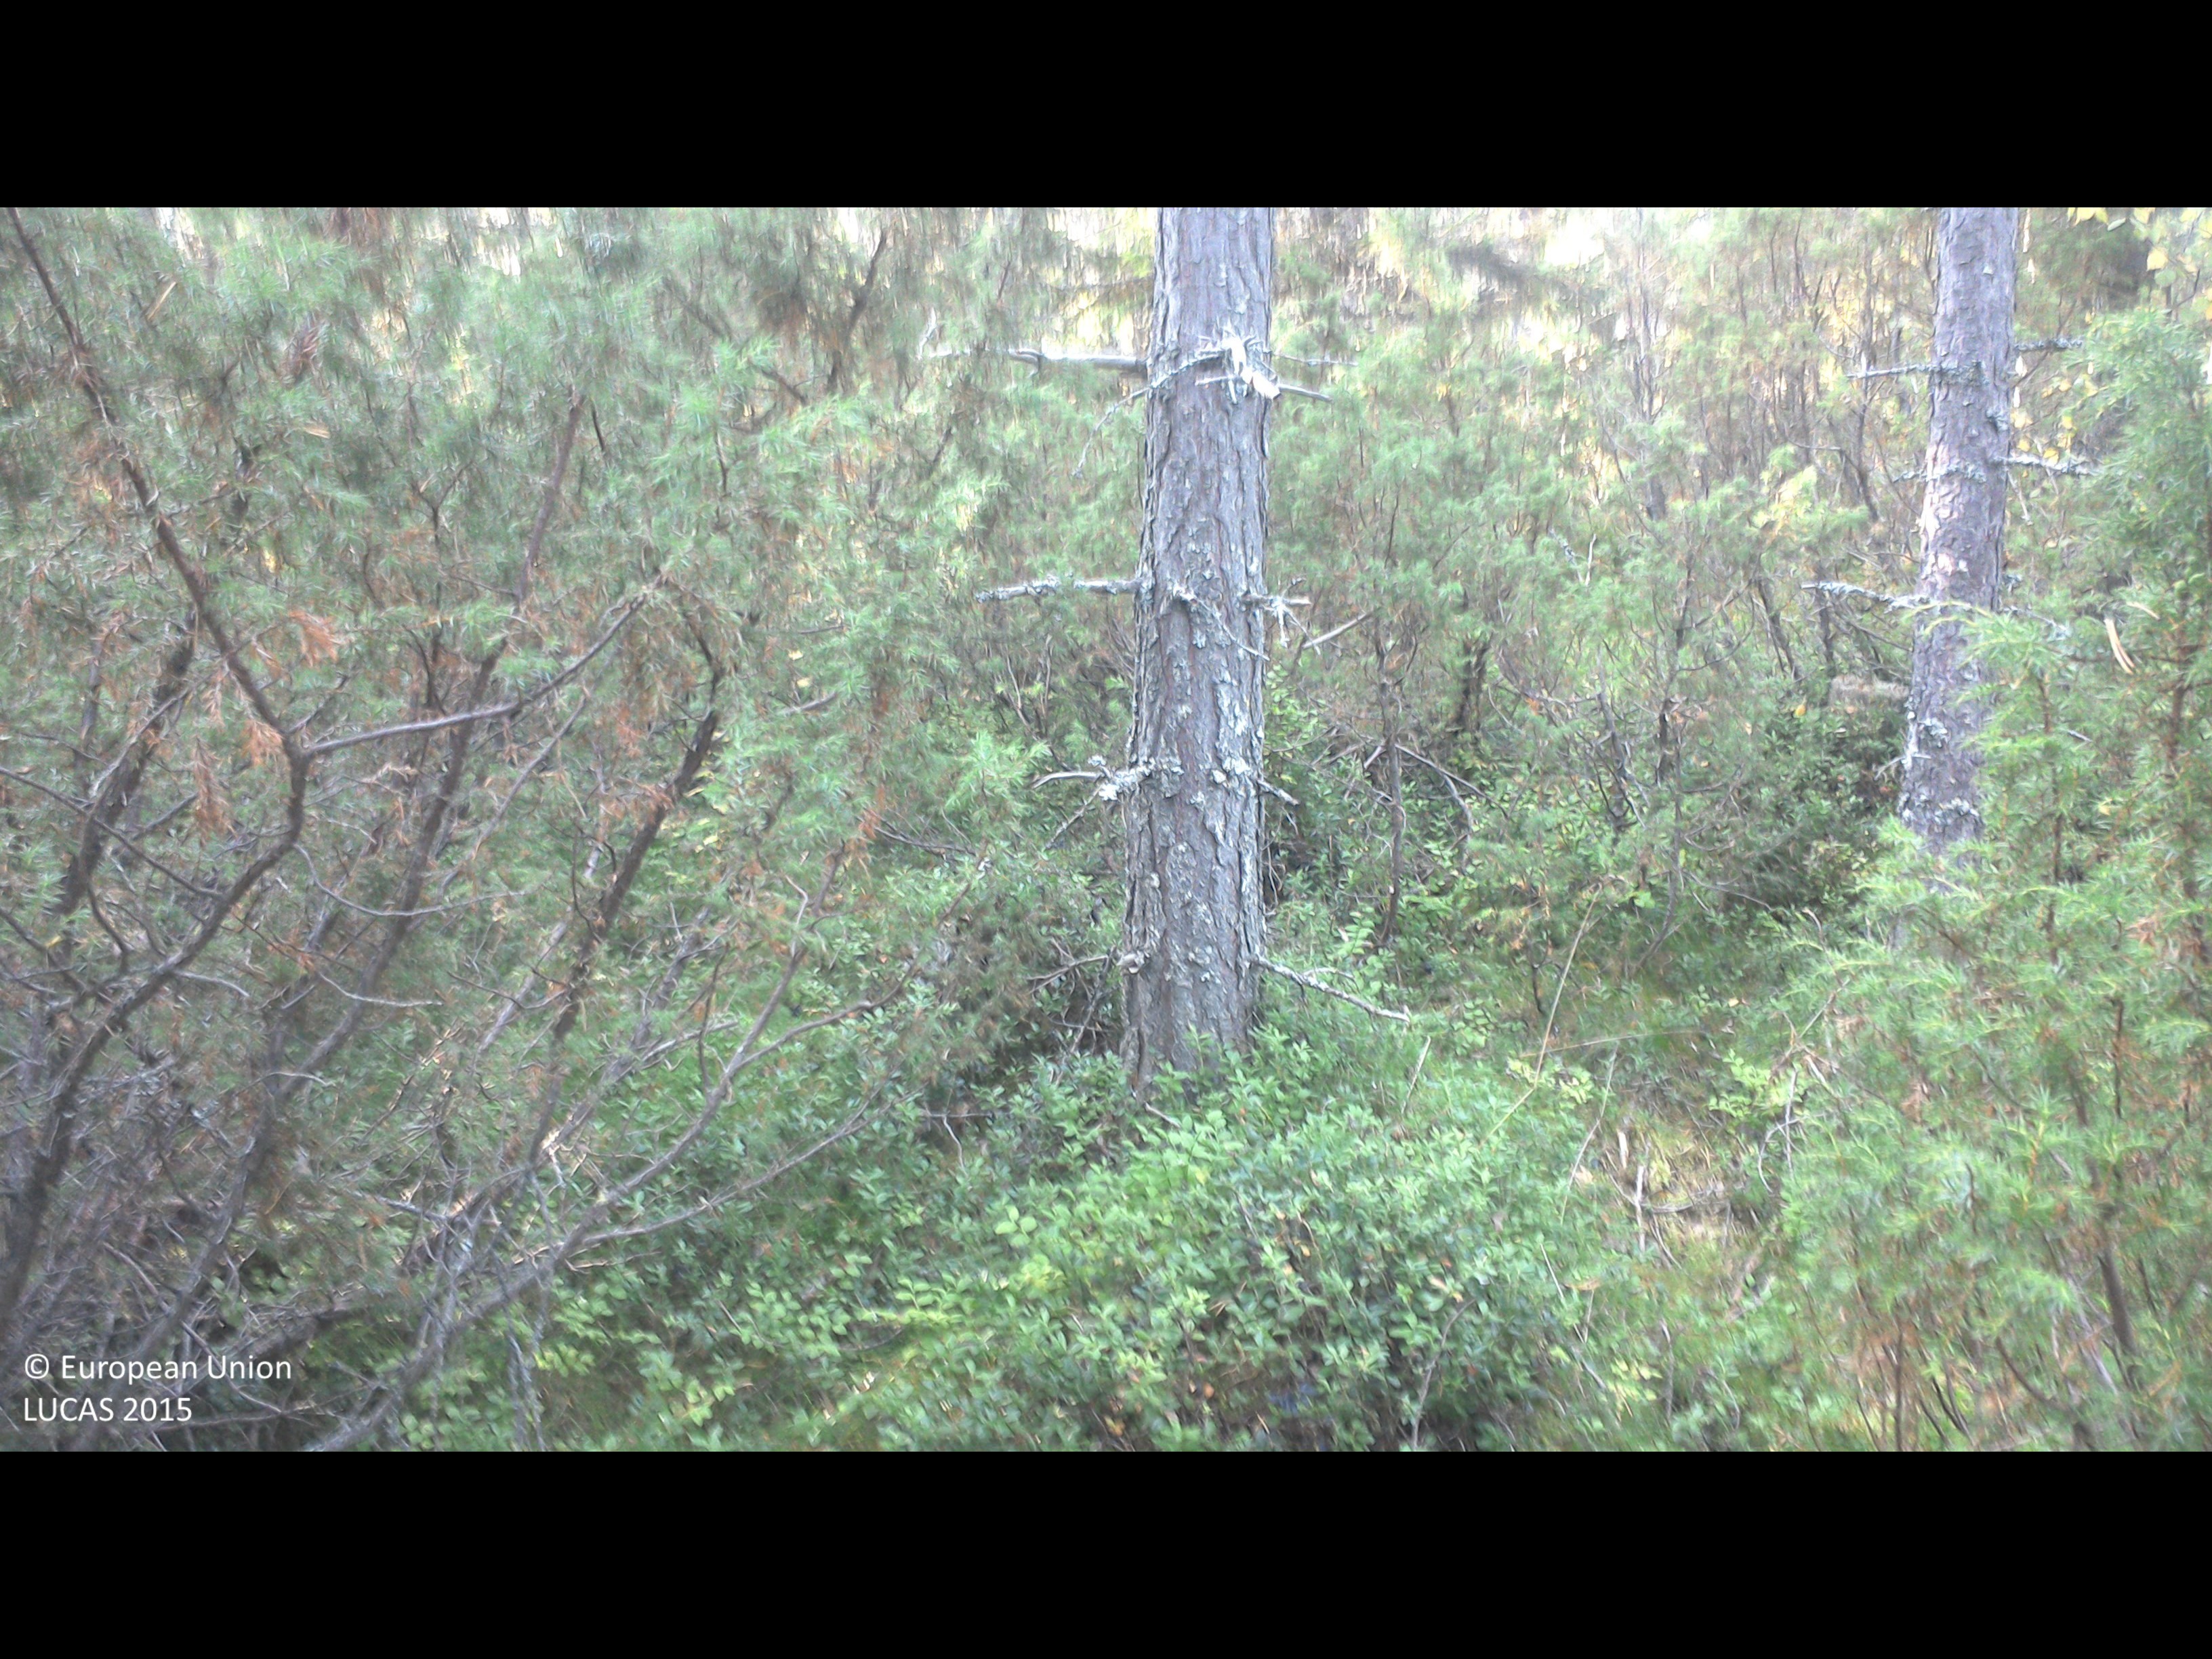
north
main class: Woodland
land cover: Pine dominated coniferous woodland
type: boreal forest
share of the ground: 50 - 75 %
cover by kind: coniferous forest trees 50 %, shrubs 50 %
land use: Forestry
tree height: > 5 m
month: September
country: SE
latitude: 63.9033
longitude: 19.9427
